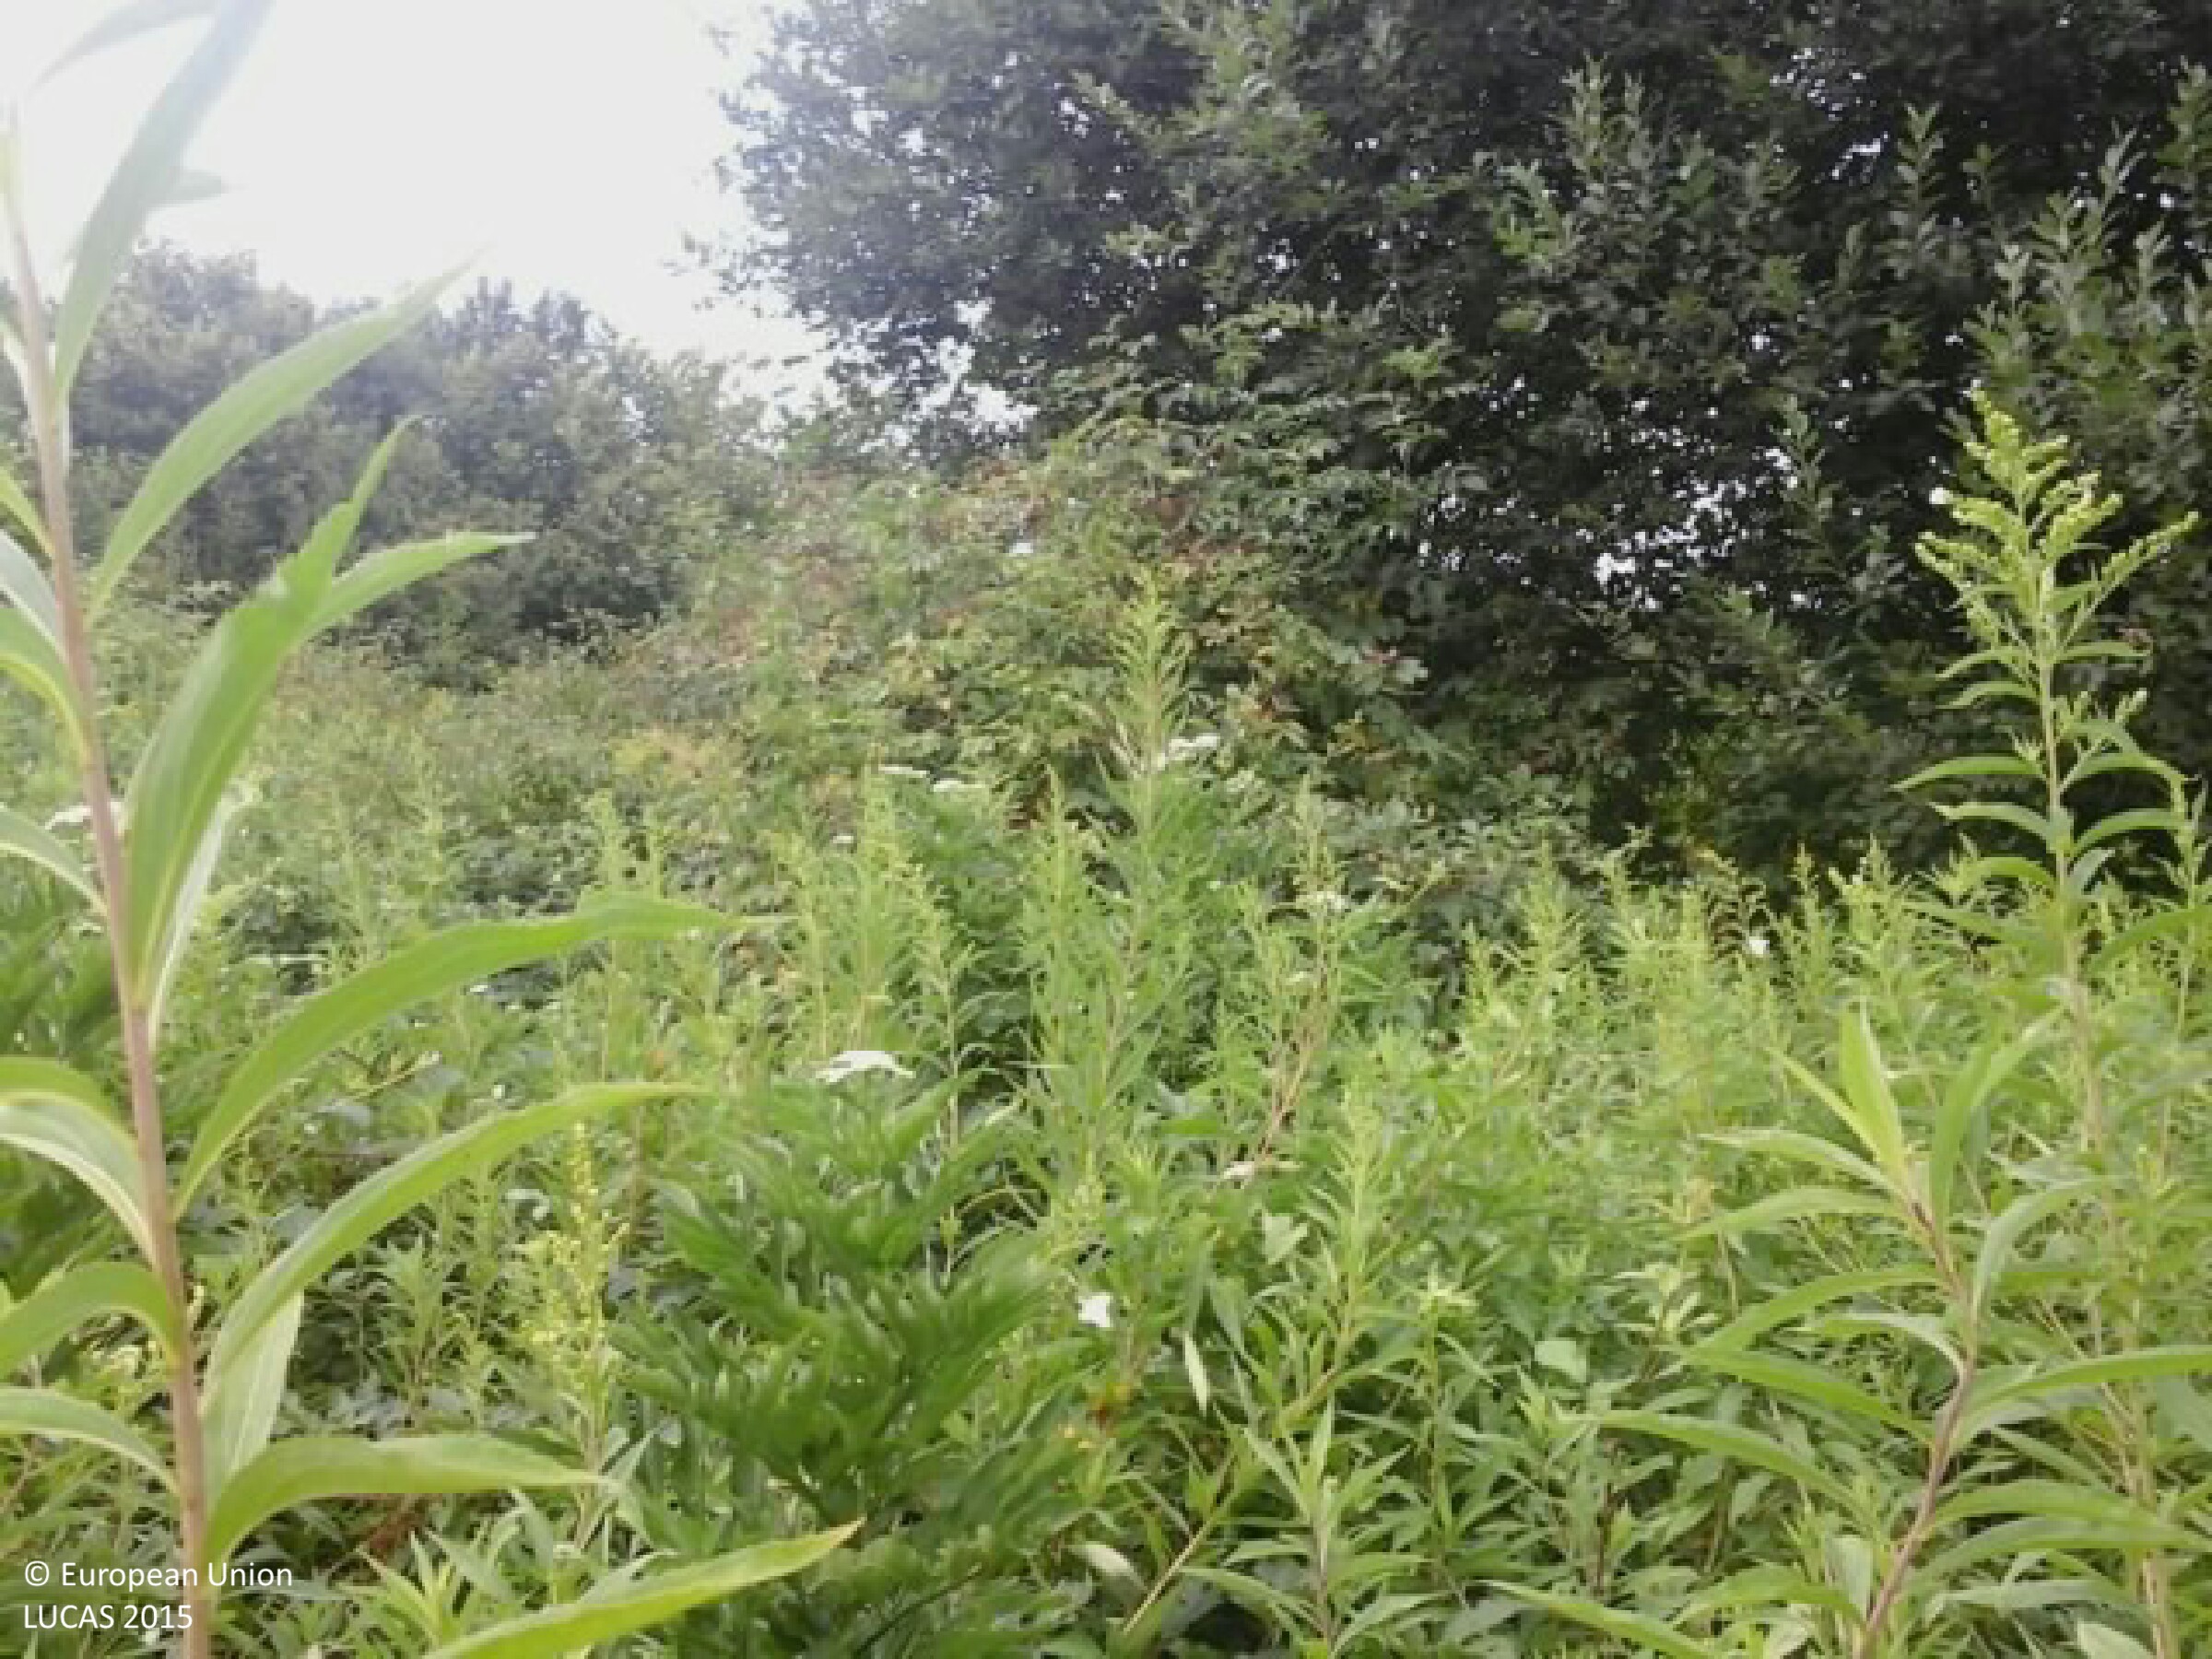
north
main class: Grassland
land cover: Spontaneously vegetated surfaces
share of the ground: > 75 %
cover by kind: herbaceous plants 95 %, shrubs 5 %
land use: Fallow land
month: August
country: HU
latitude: 46.2496
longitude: 18.0096
